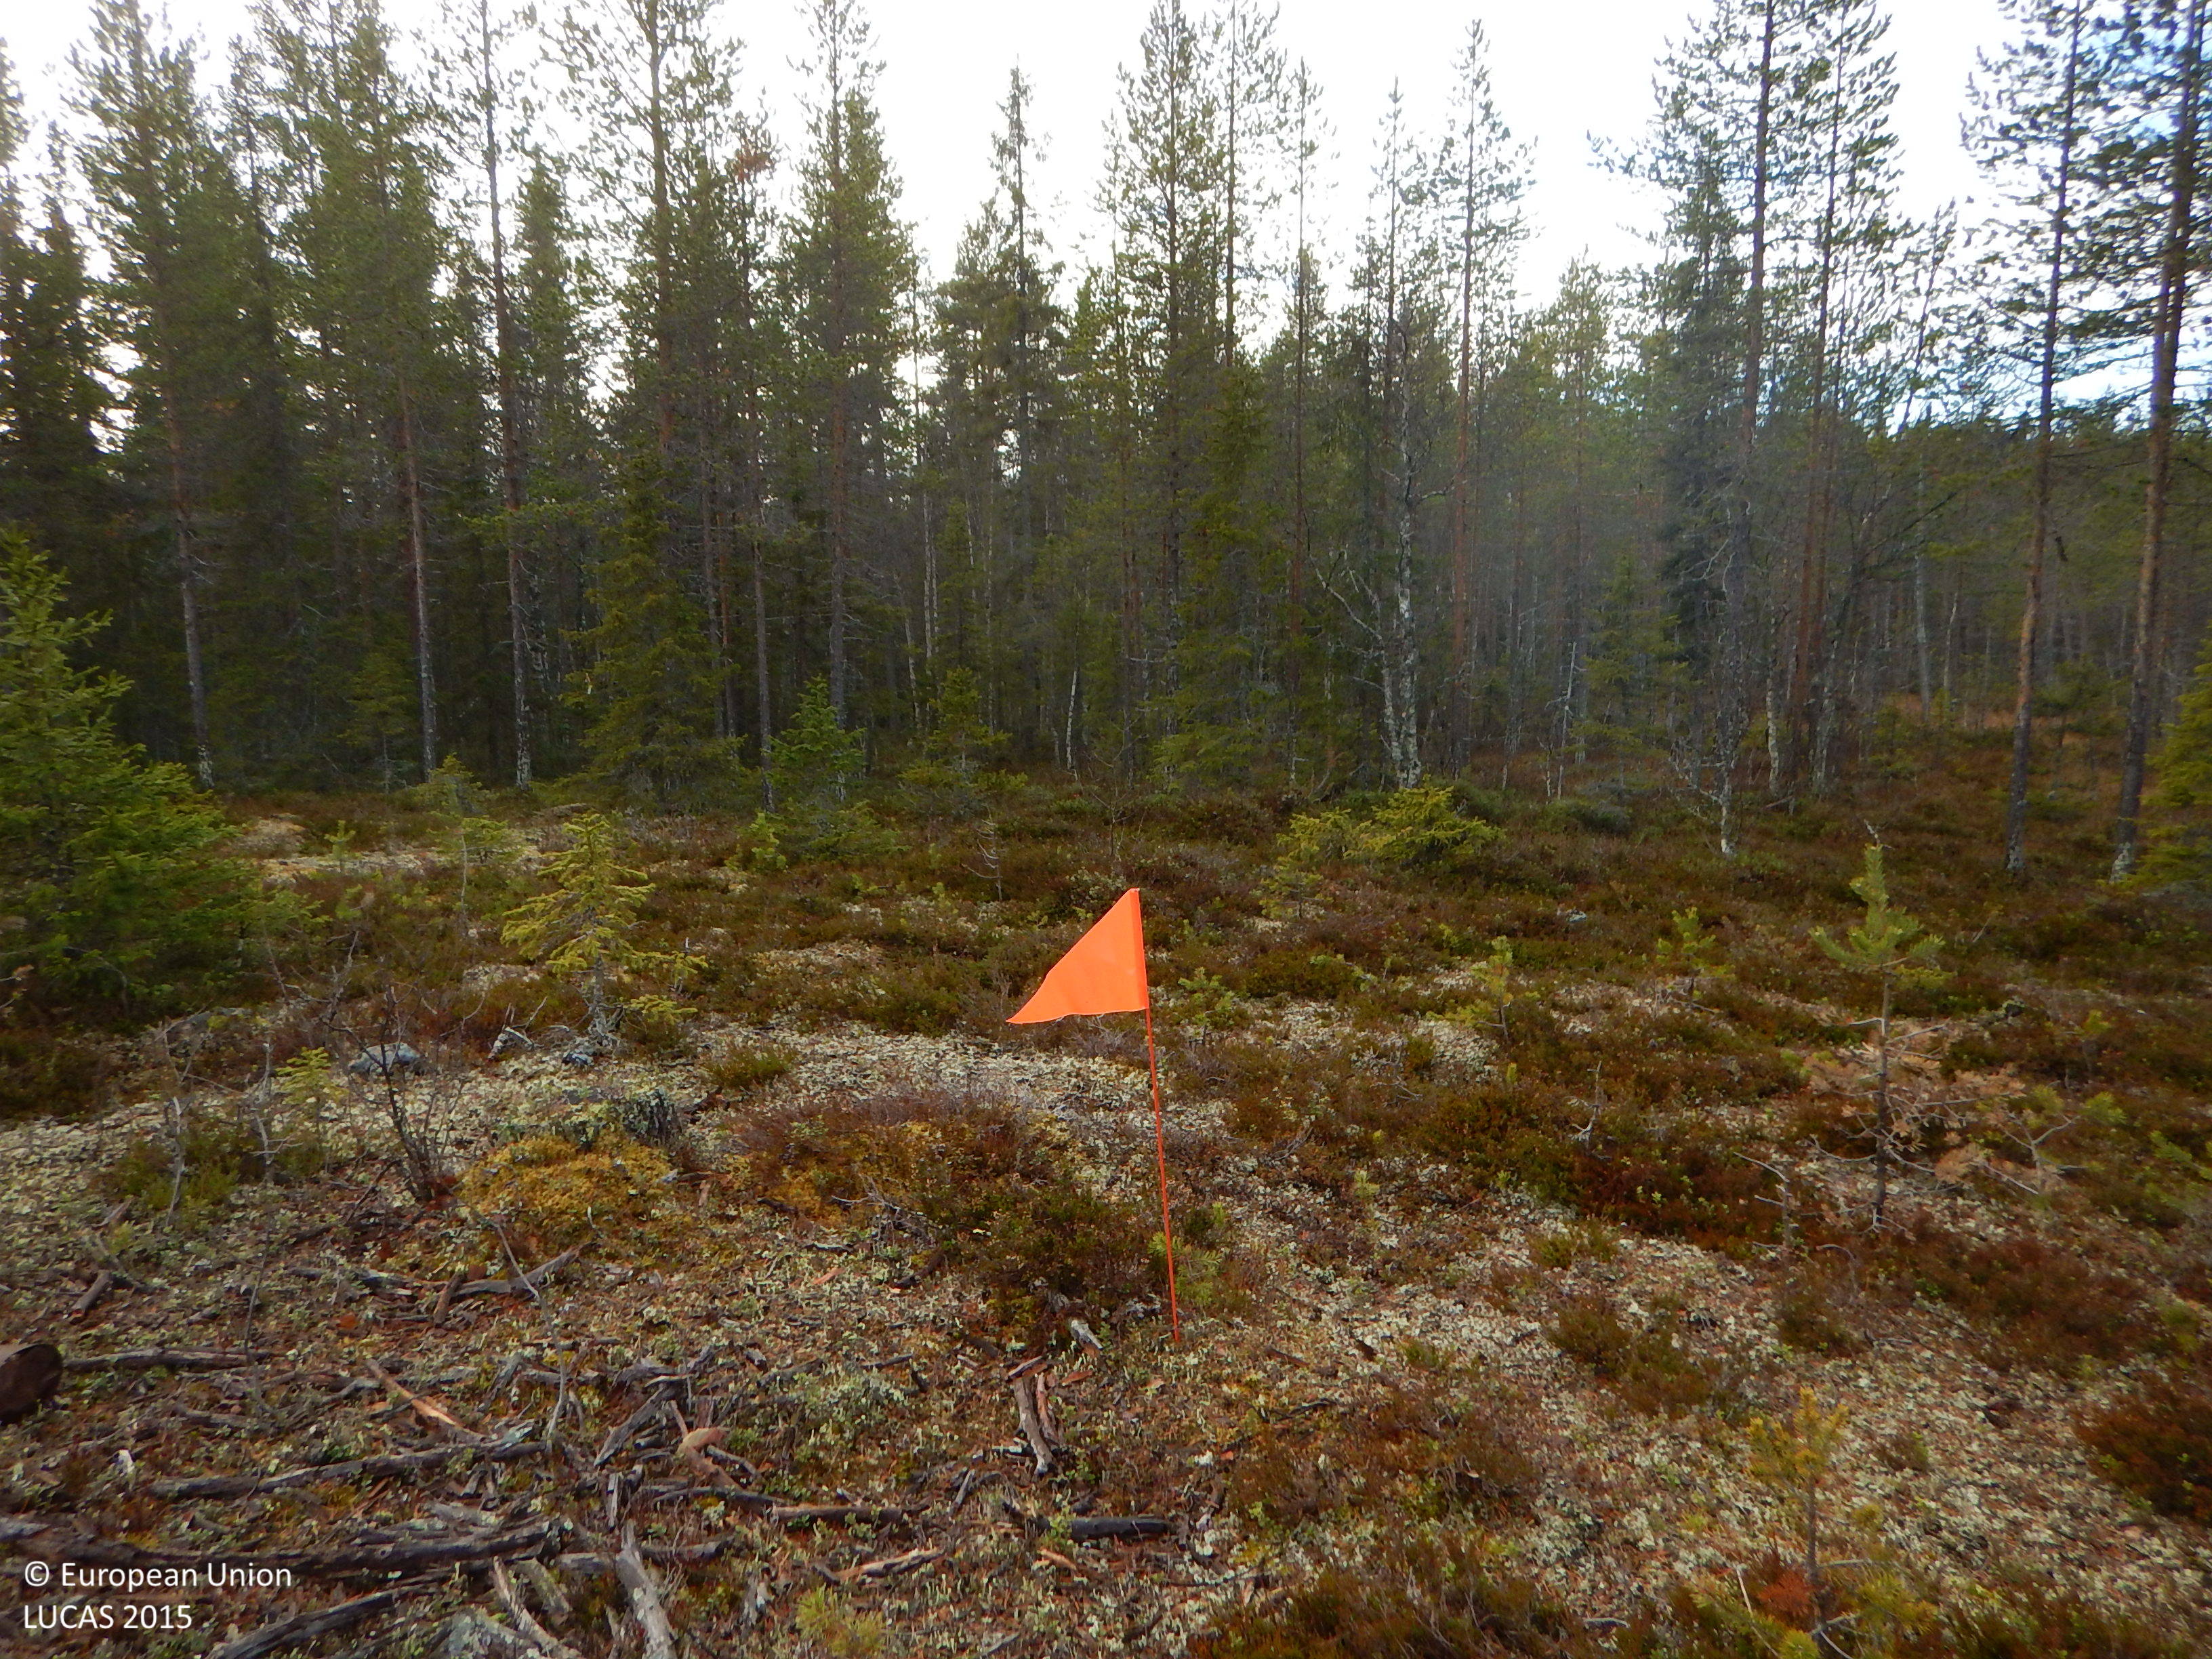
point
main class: Woodland
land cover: Pine dominated coniferous woodland
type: boreal forest
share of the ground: 10 - 25 %
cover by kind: shrubs 50 %, coniferous forest trees 25 %, lichens and mosses 20 %, herbaceous plants 5 %
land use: Forestry
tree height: < 5 m
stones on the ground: < 10 %
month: October
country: SE
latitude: 65.2818
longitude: 20.0617
